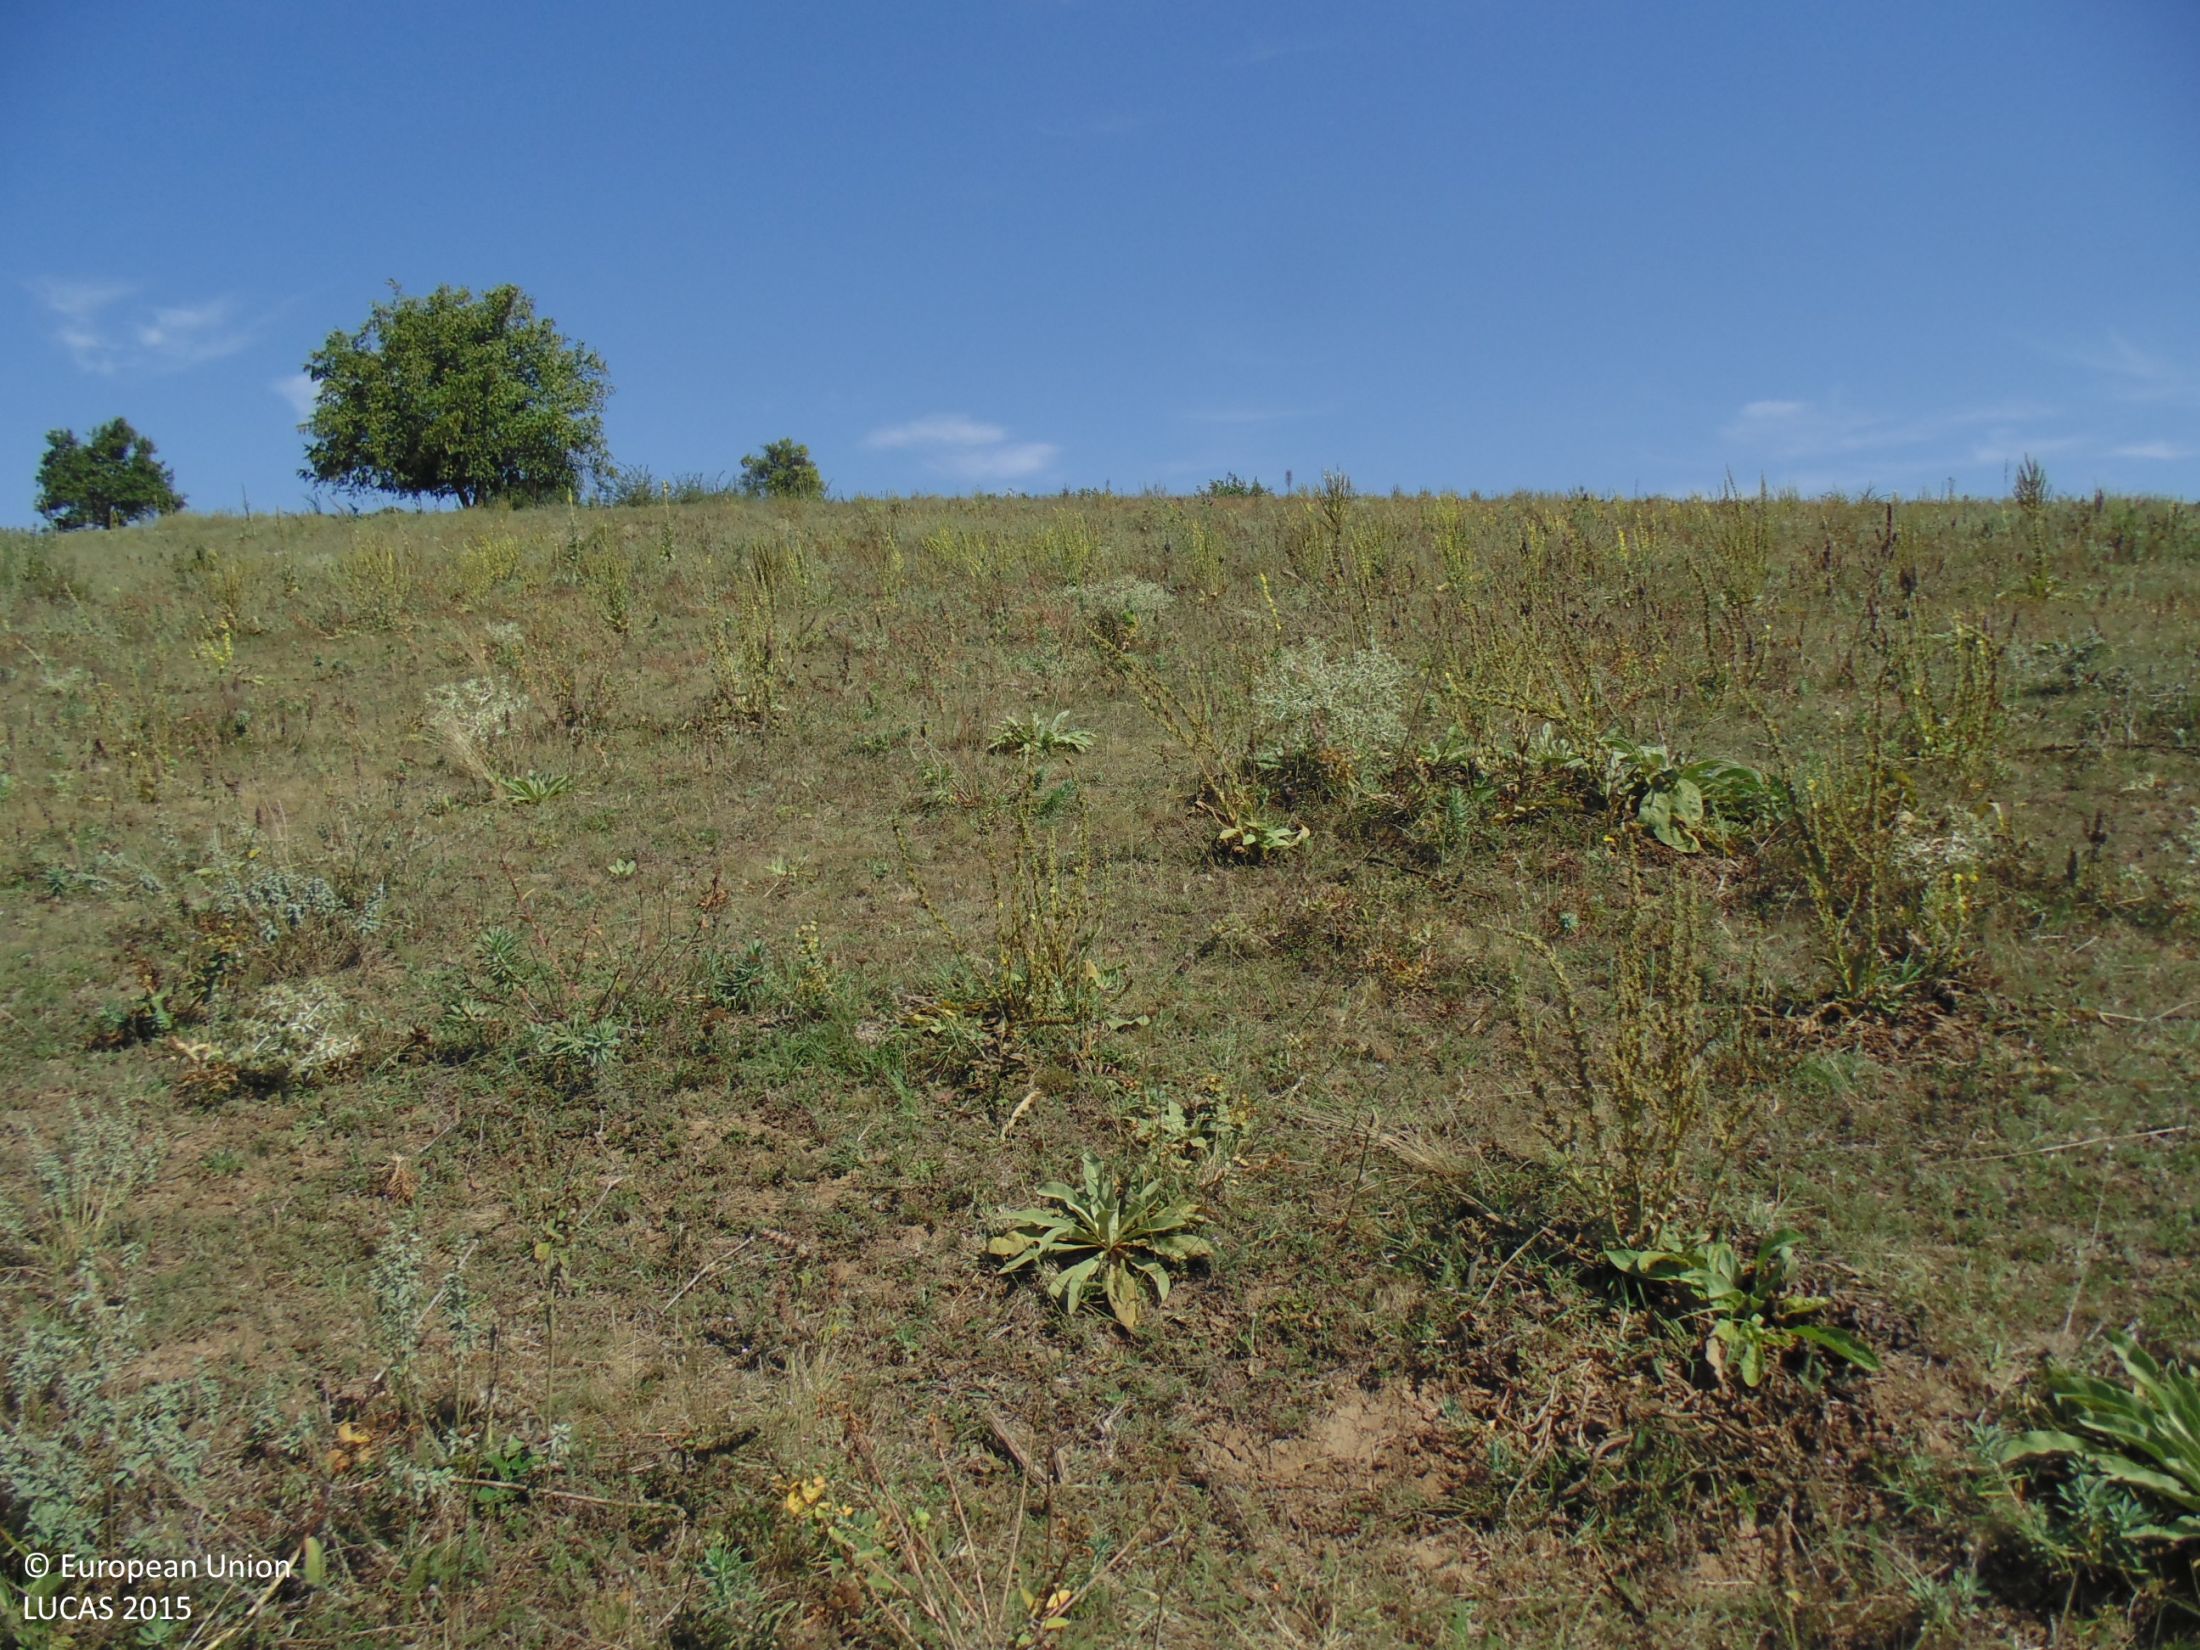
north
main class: Grassland
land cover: Grassland without tree/shrub cover
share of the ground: > 75 %
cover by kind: herbaceous plants 100 %
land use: Agriculture (excluding fallow land and kitchen gardens)
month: August
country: BG
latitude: 43.6397
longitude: 28.2406
